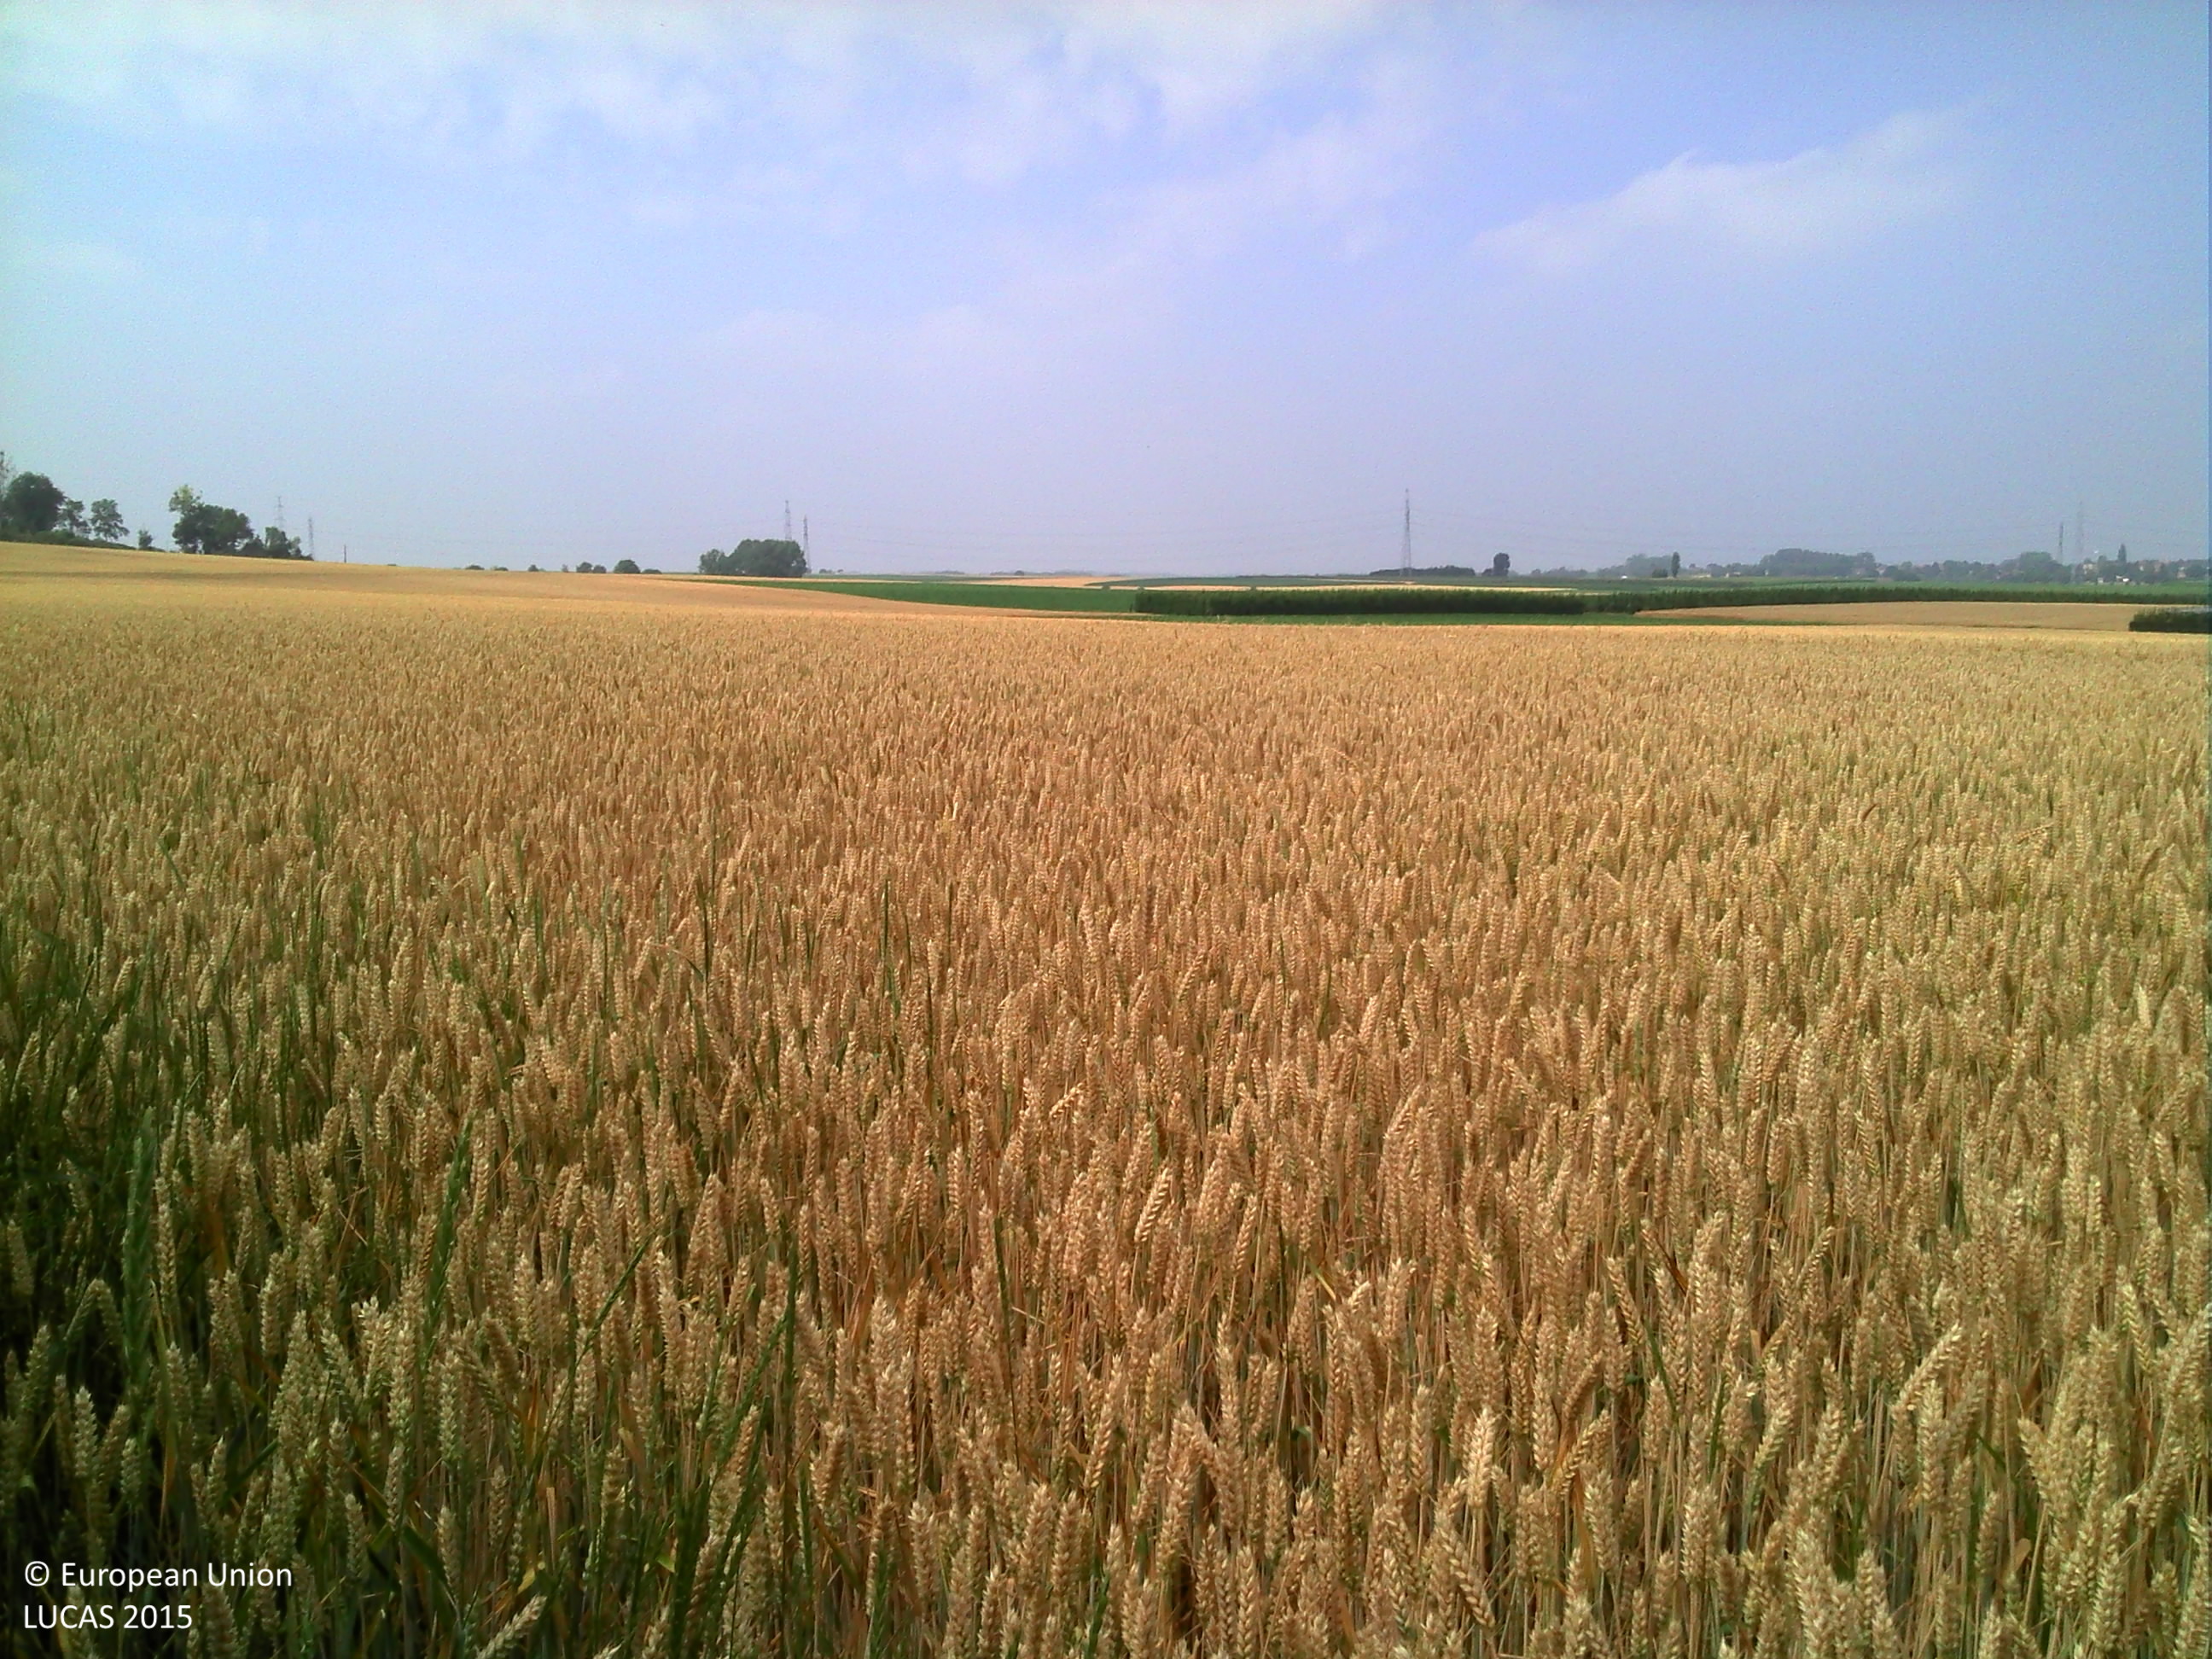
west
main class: Cropland
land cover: Common wheat
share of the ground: > 75 %
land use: Agriculture (excluding fallow land and kitchen gardens)
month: July
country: BE
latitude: 50.8190
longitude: 5.5838
